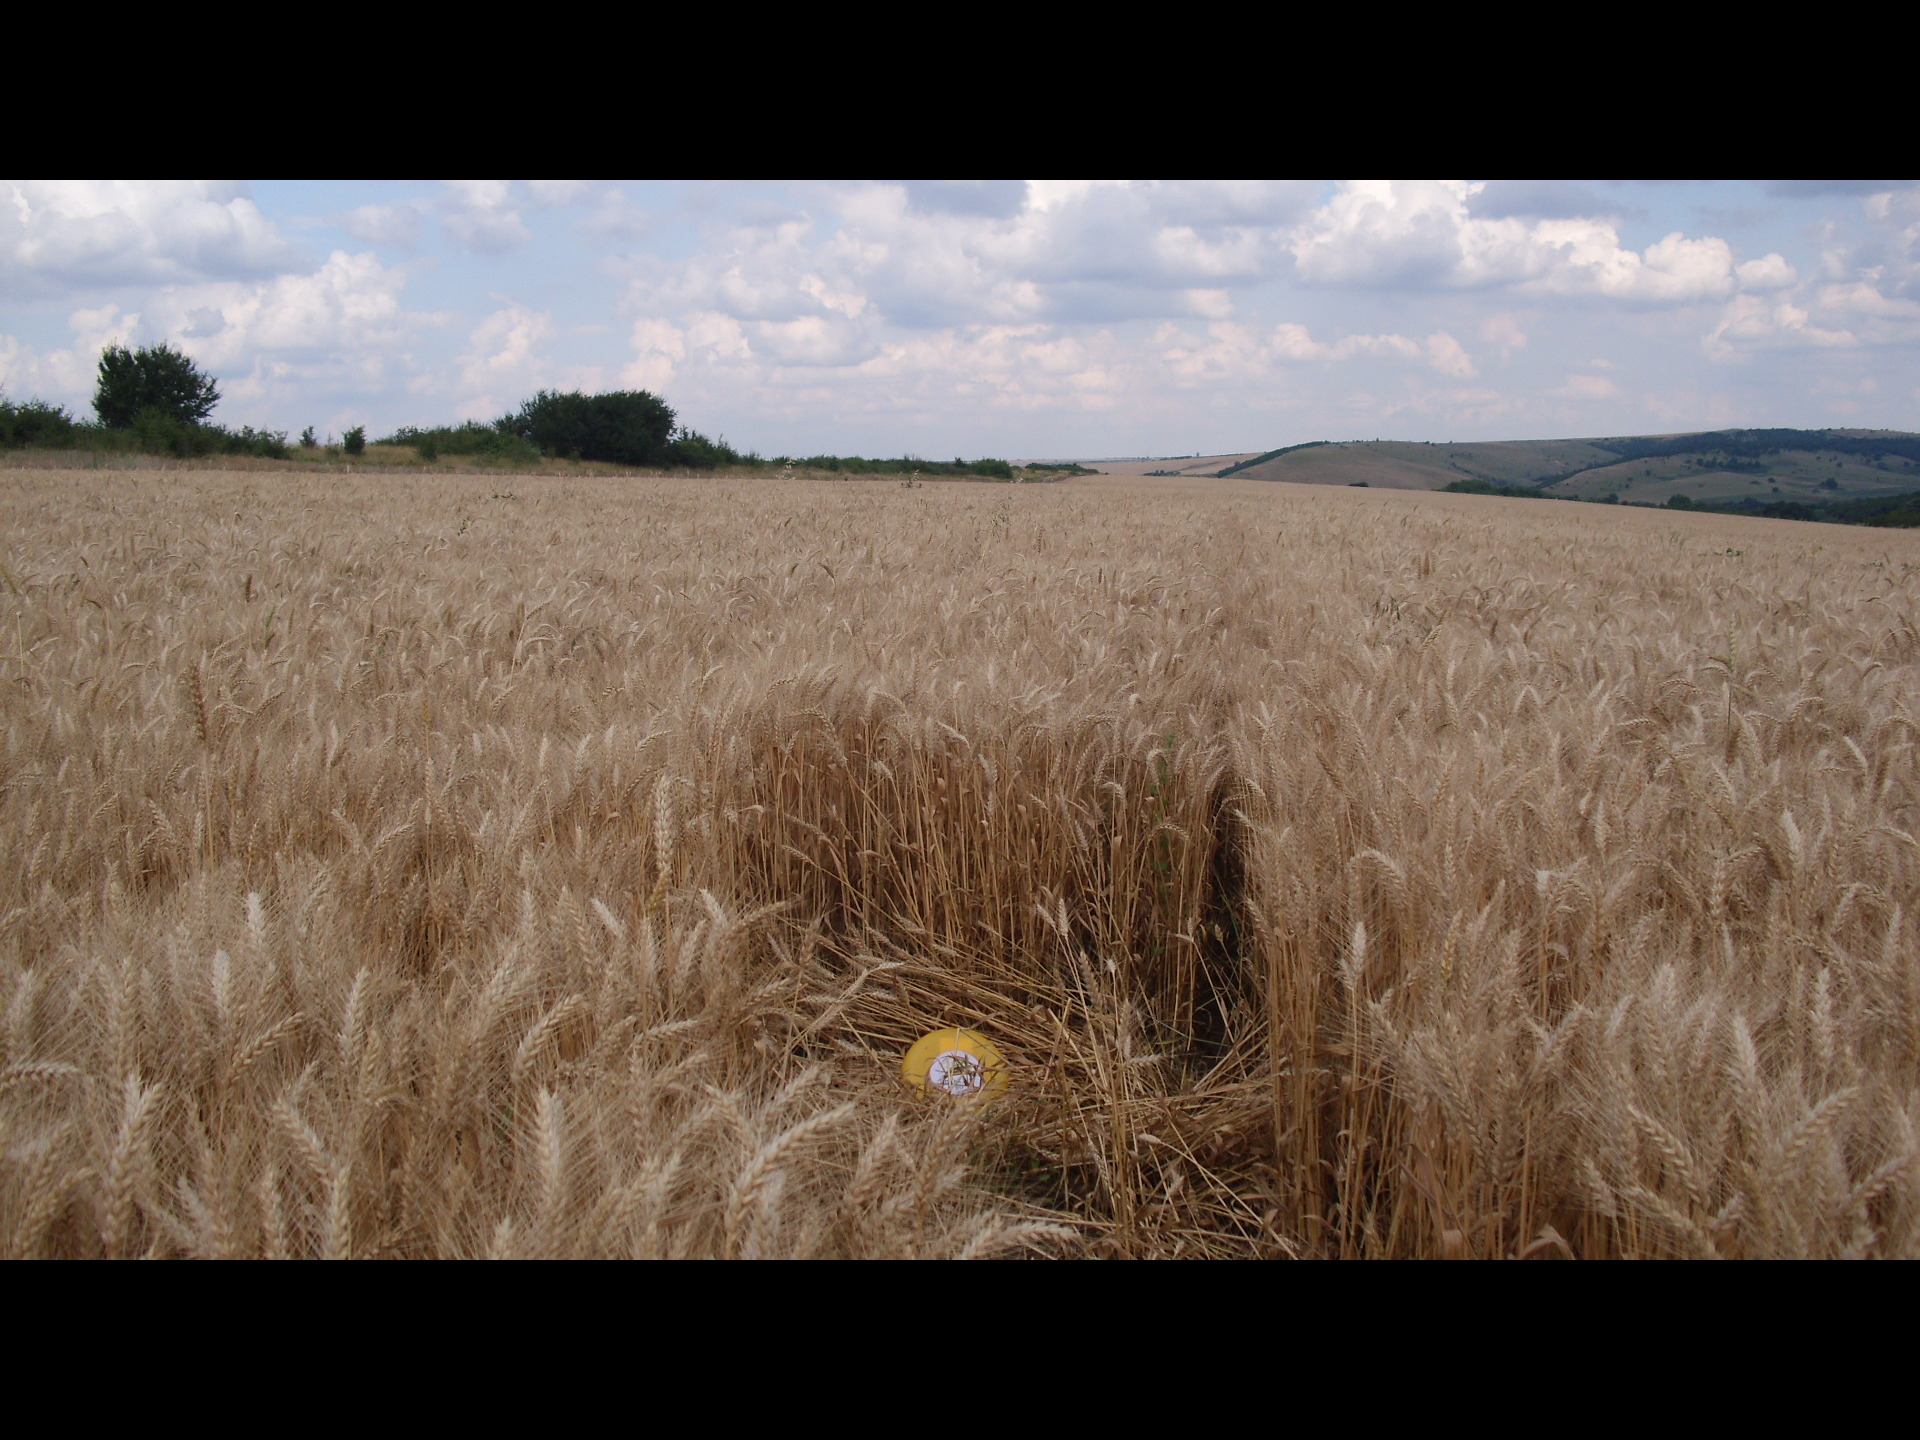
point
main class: Cropland
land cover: Common wheat
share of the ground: > 75 %
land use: Agriculture (excluding fallow land and kitchen gardens)
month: June
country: BG
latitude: 43.4631
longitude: 23.5044
